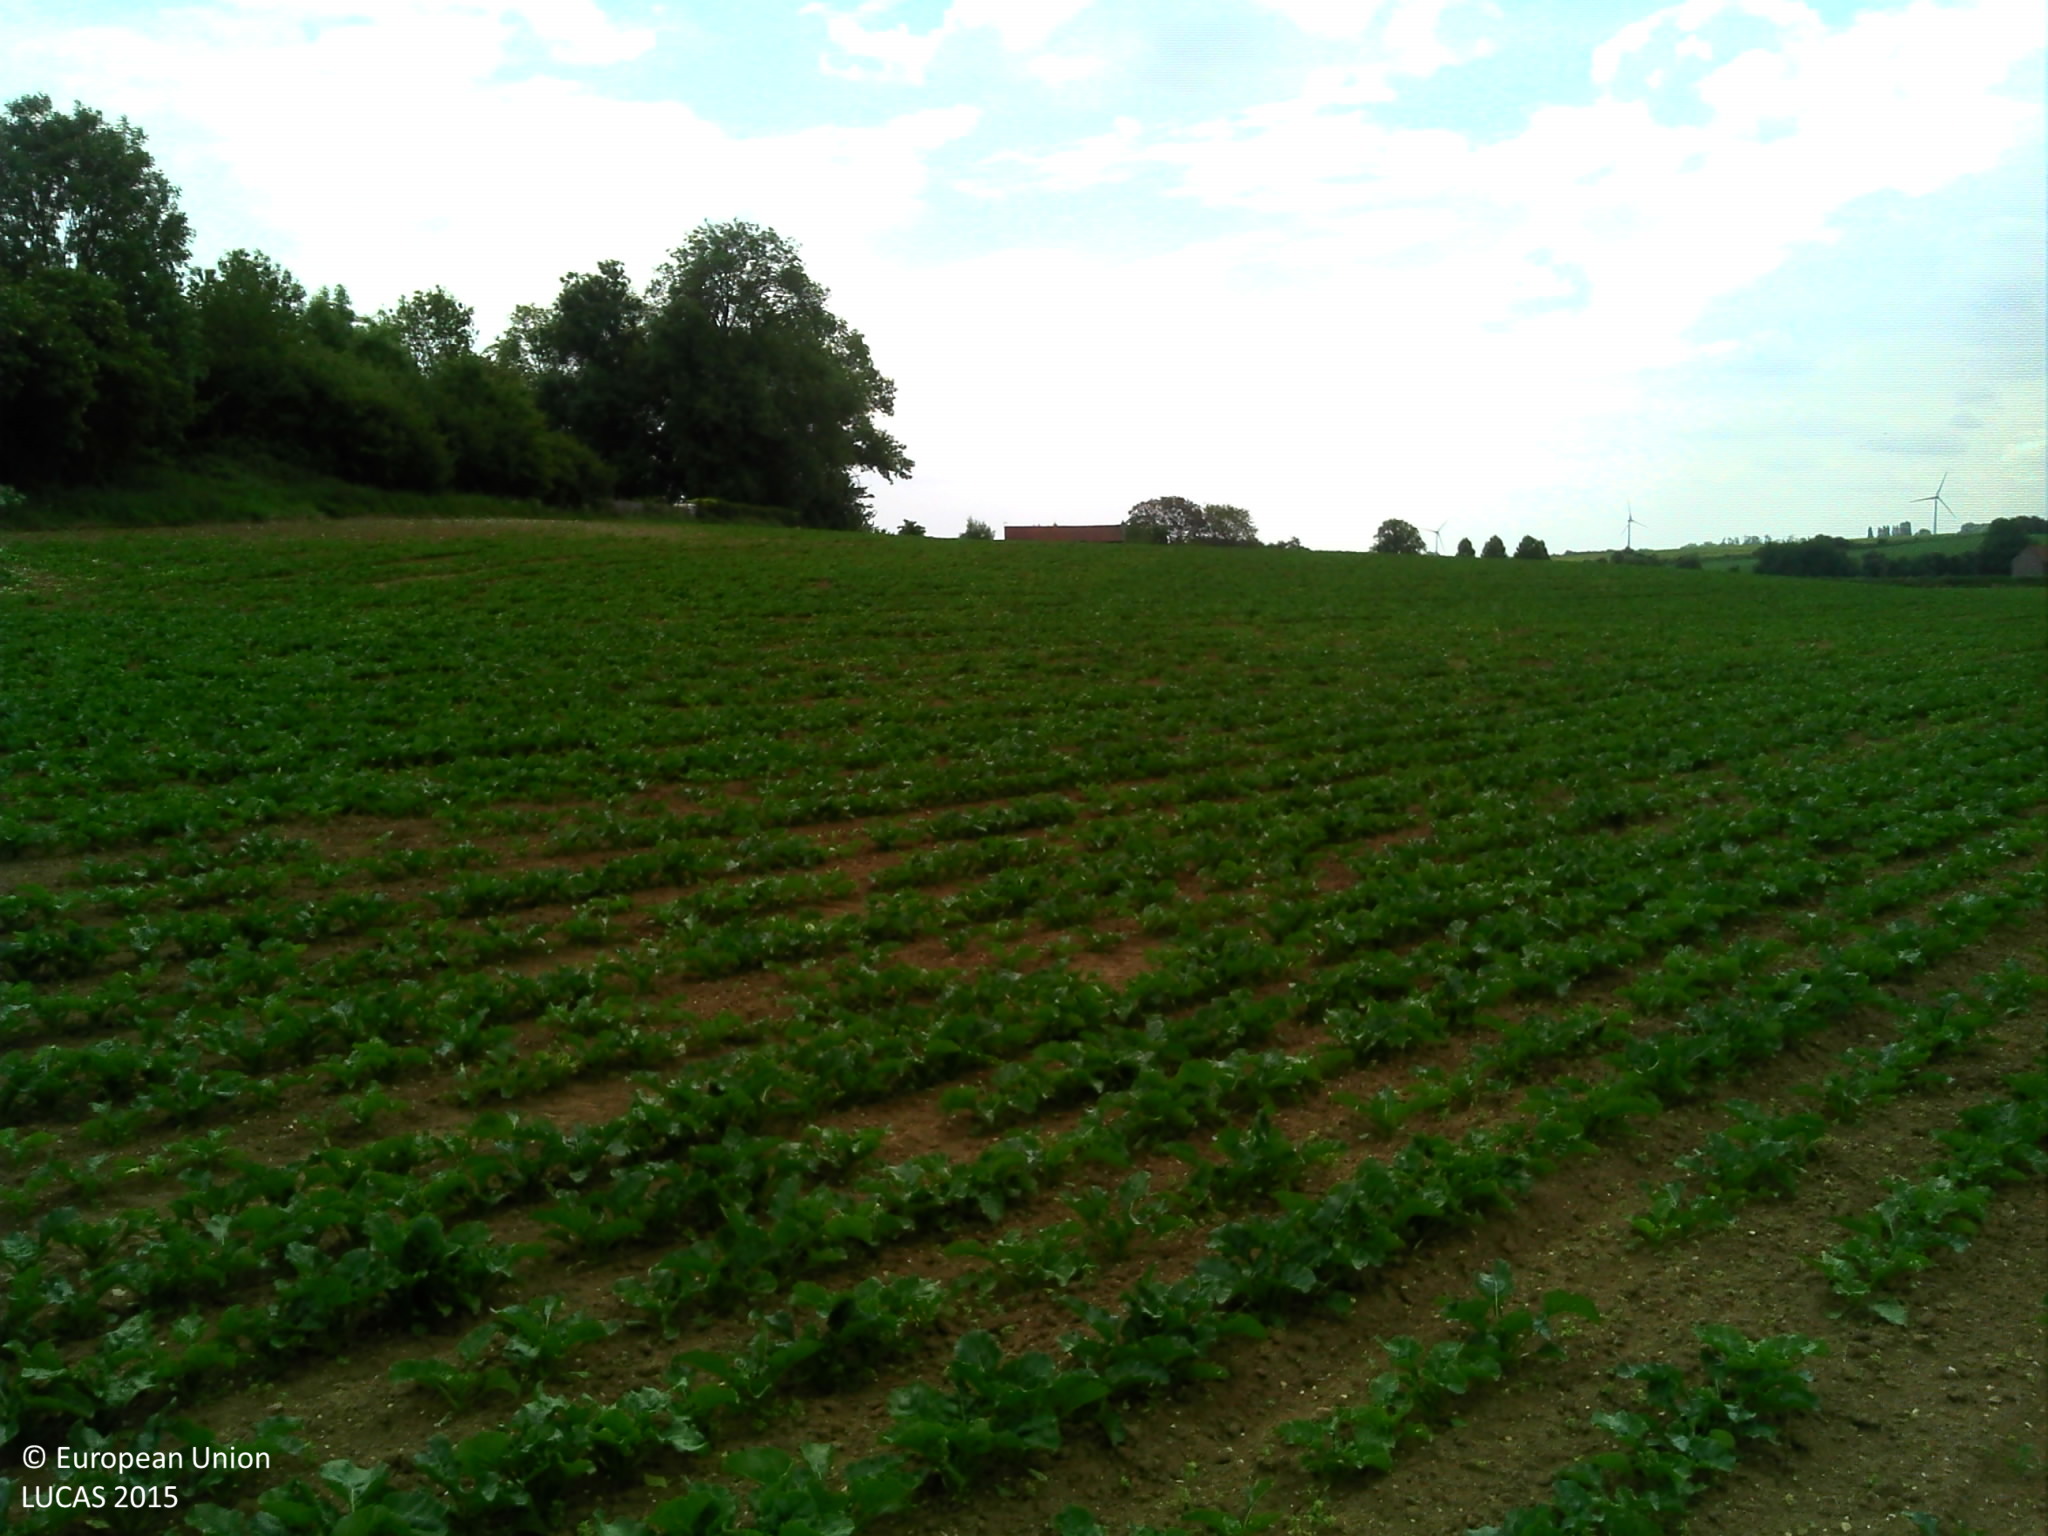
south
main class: Cropland
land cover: Sugar beet
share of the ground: > 75 %
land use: Agriculture (excluding fallow land and kitchen gardens)
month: May
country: FR
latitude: 49.9649
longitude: 3.2300
